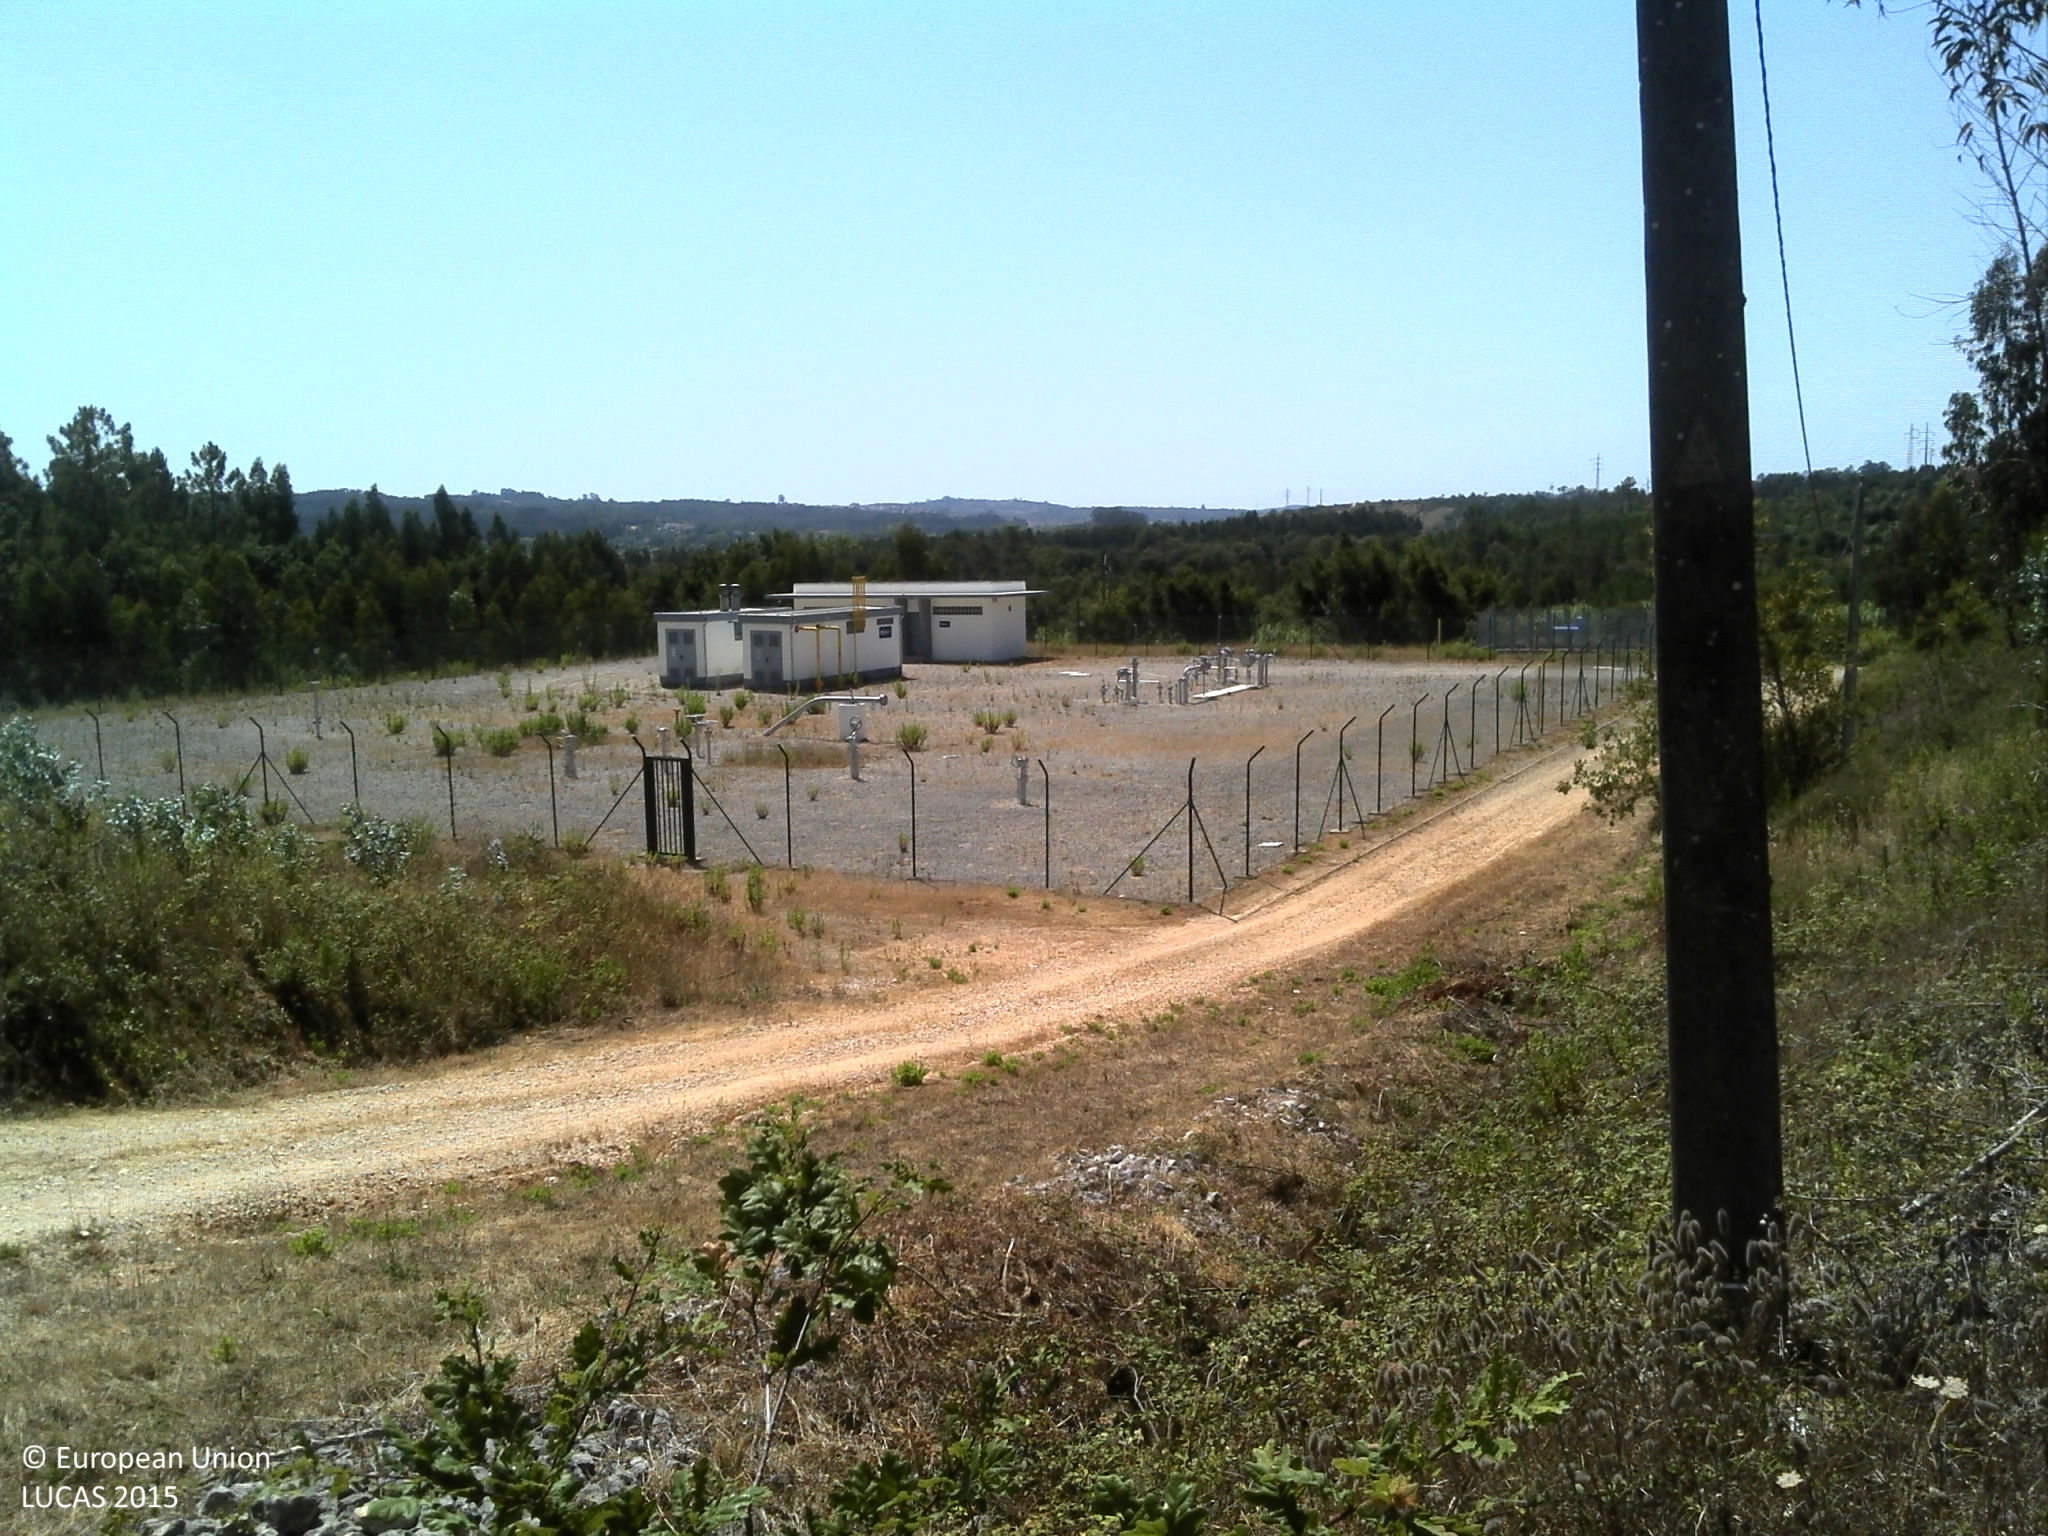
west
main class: Shrubland
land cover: Shrubland with sparse tree cover
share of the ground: 25 - 50 %
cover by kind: unconsolidated bare surface 60 %, shrubs 25 %, herbaceous plants 10 %, broadleaved forest trees 5 %
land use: Forestry
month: July
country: PT
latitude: 40.1458
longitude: -8.6468
